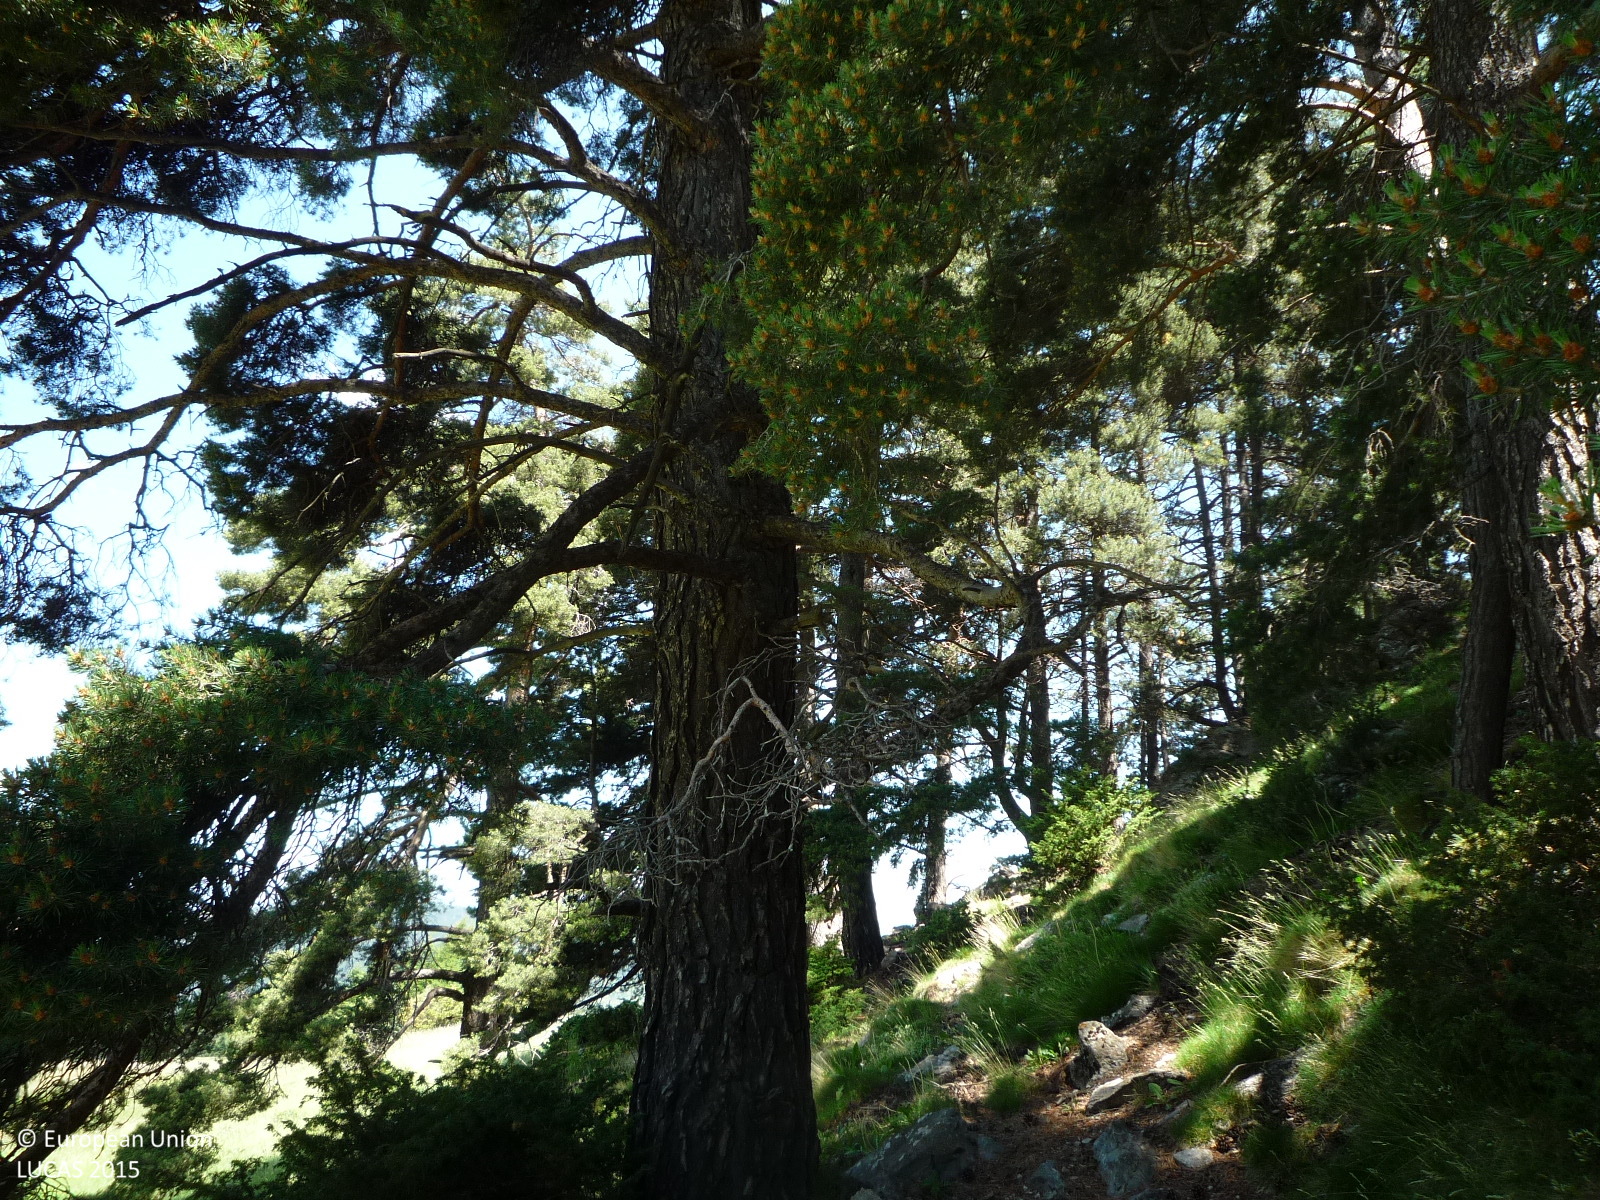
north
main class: Woodland
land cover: Pine dominated coniferous woodland
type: alpine coniferous forest
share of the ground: > 75 %
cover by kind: coniferous forest trees 80 %, shrubs 10 %, herbaceous plants 10 %
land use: Sport
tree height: > 5 m
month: June
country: ES
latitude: 42.3325
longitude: 1.9412
